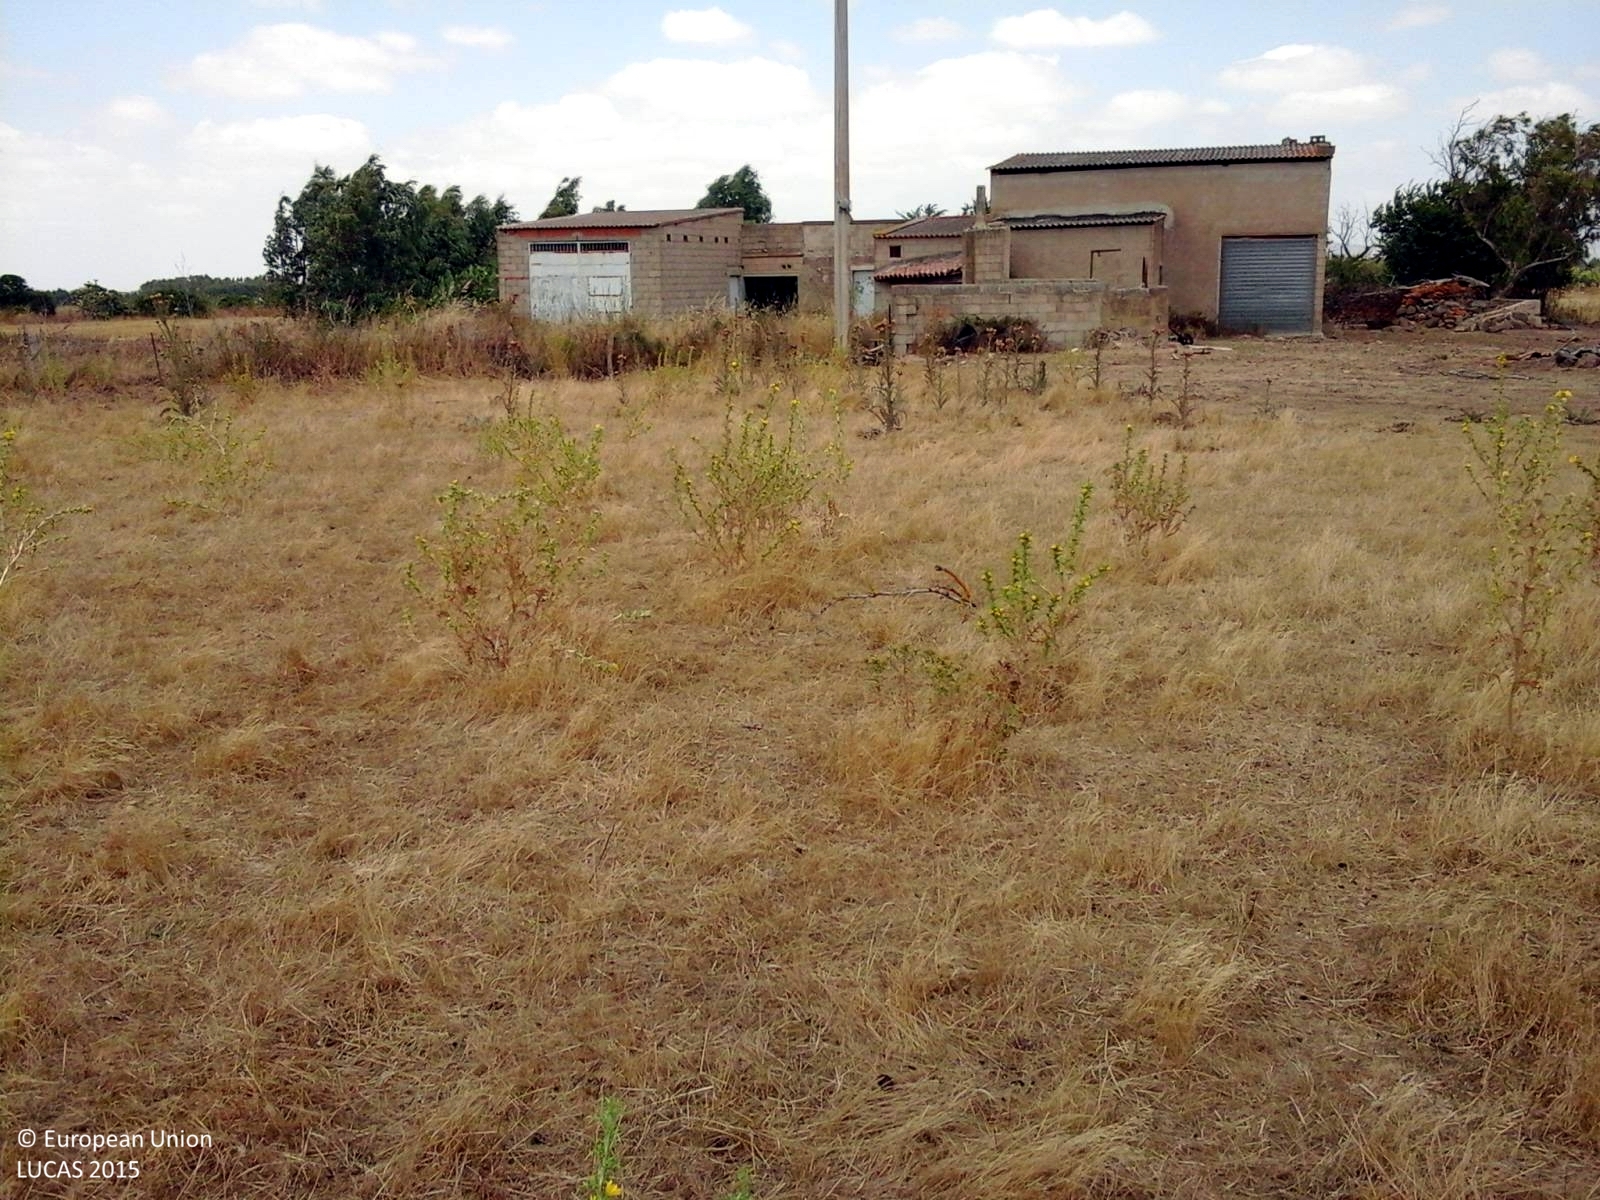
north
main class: Cropland
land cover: Mixed cereals for fodder
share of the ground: > 75 %
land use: Agriculture (excluding fallow land and kitchen gardens)
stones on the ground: < 10 %
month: June
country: IT
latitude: 39.6241
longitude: 8.6449
